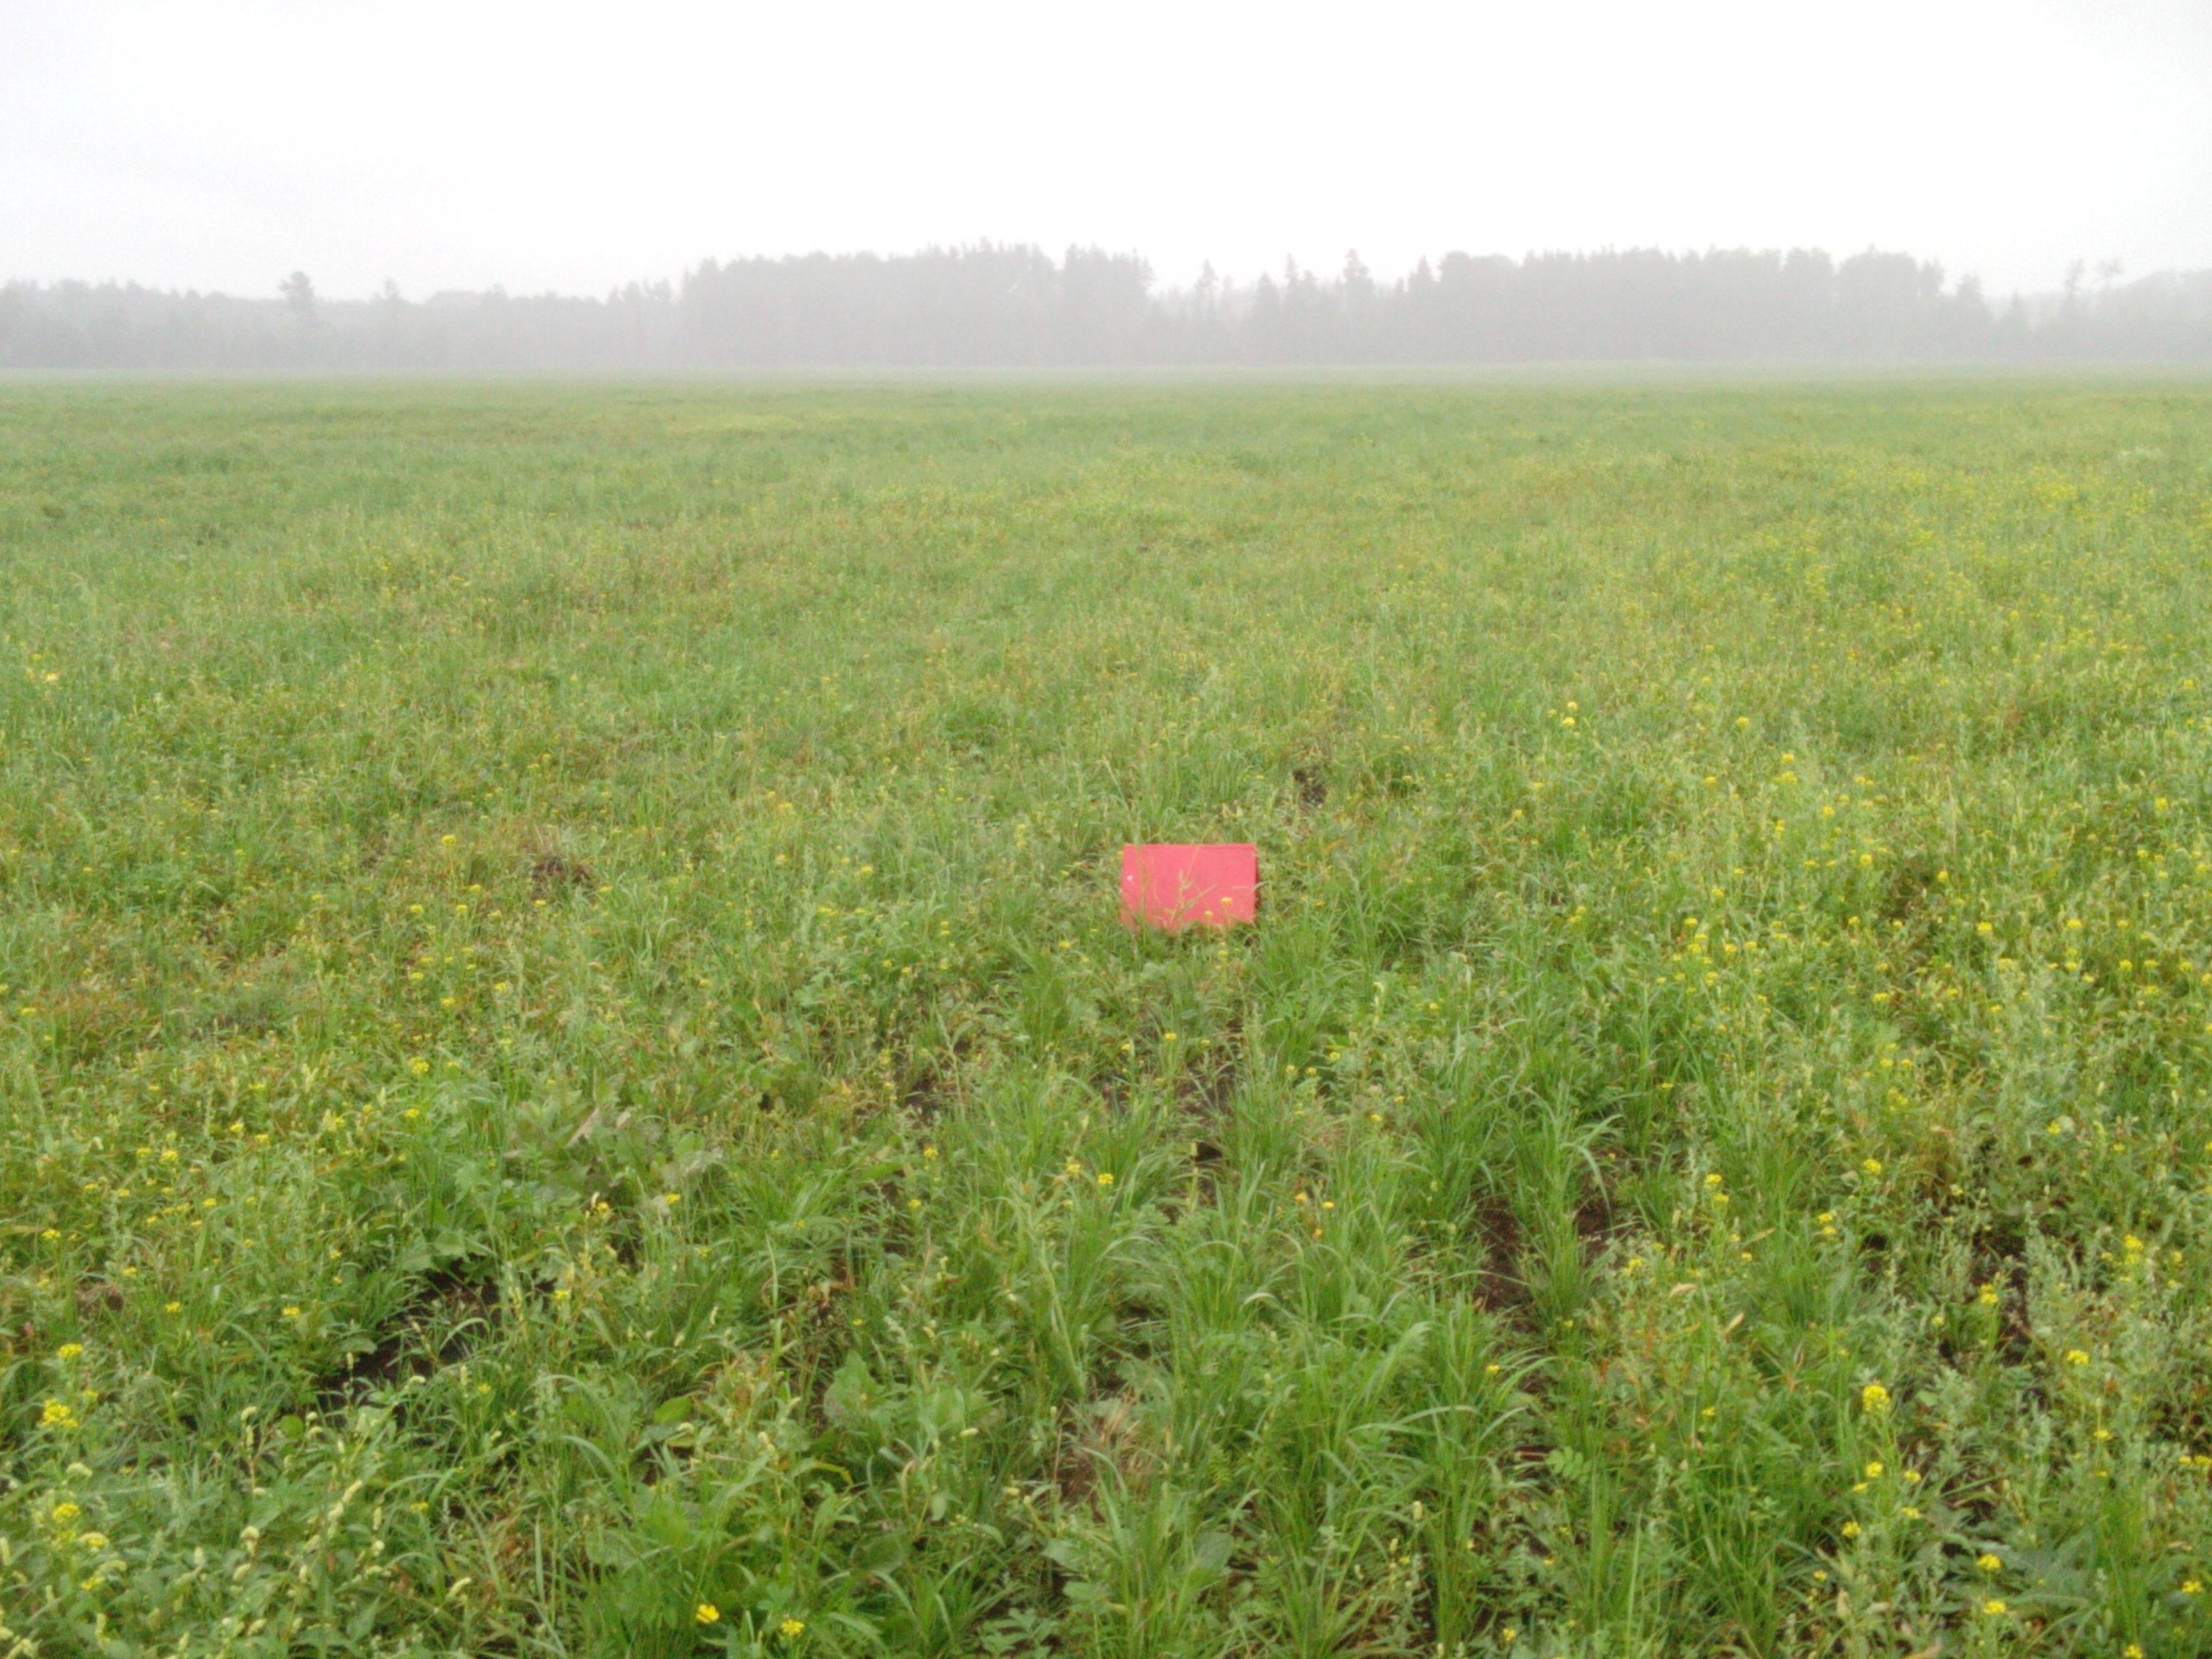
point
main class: Grassland
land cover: Spontaneously vegetated surfaces
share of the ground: > 75 %
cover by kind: herbaceous plants 100 %
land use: Fallow land
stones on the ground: < 10 %
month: September
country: LT
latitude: 55.9588
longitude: 22.4726
